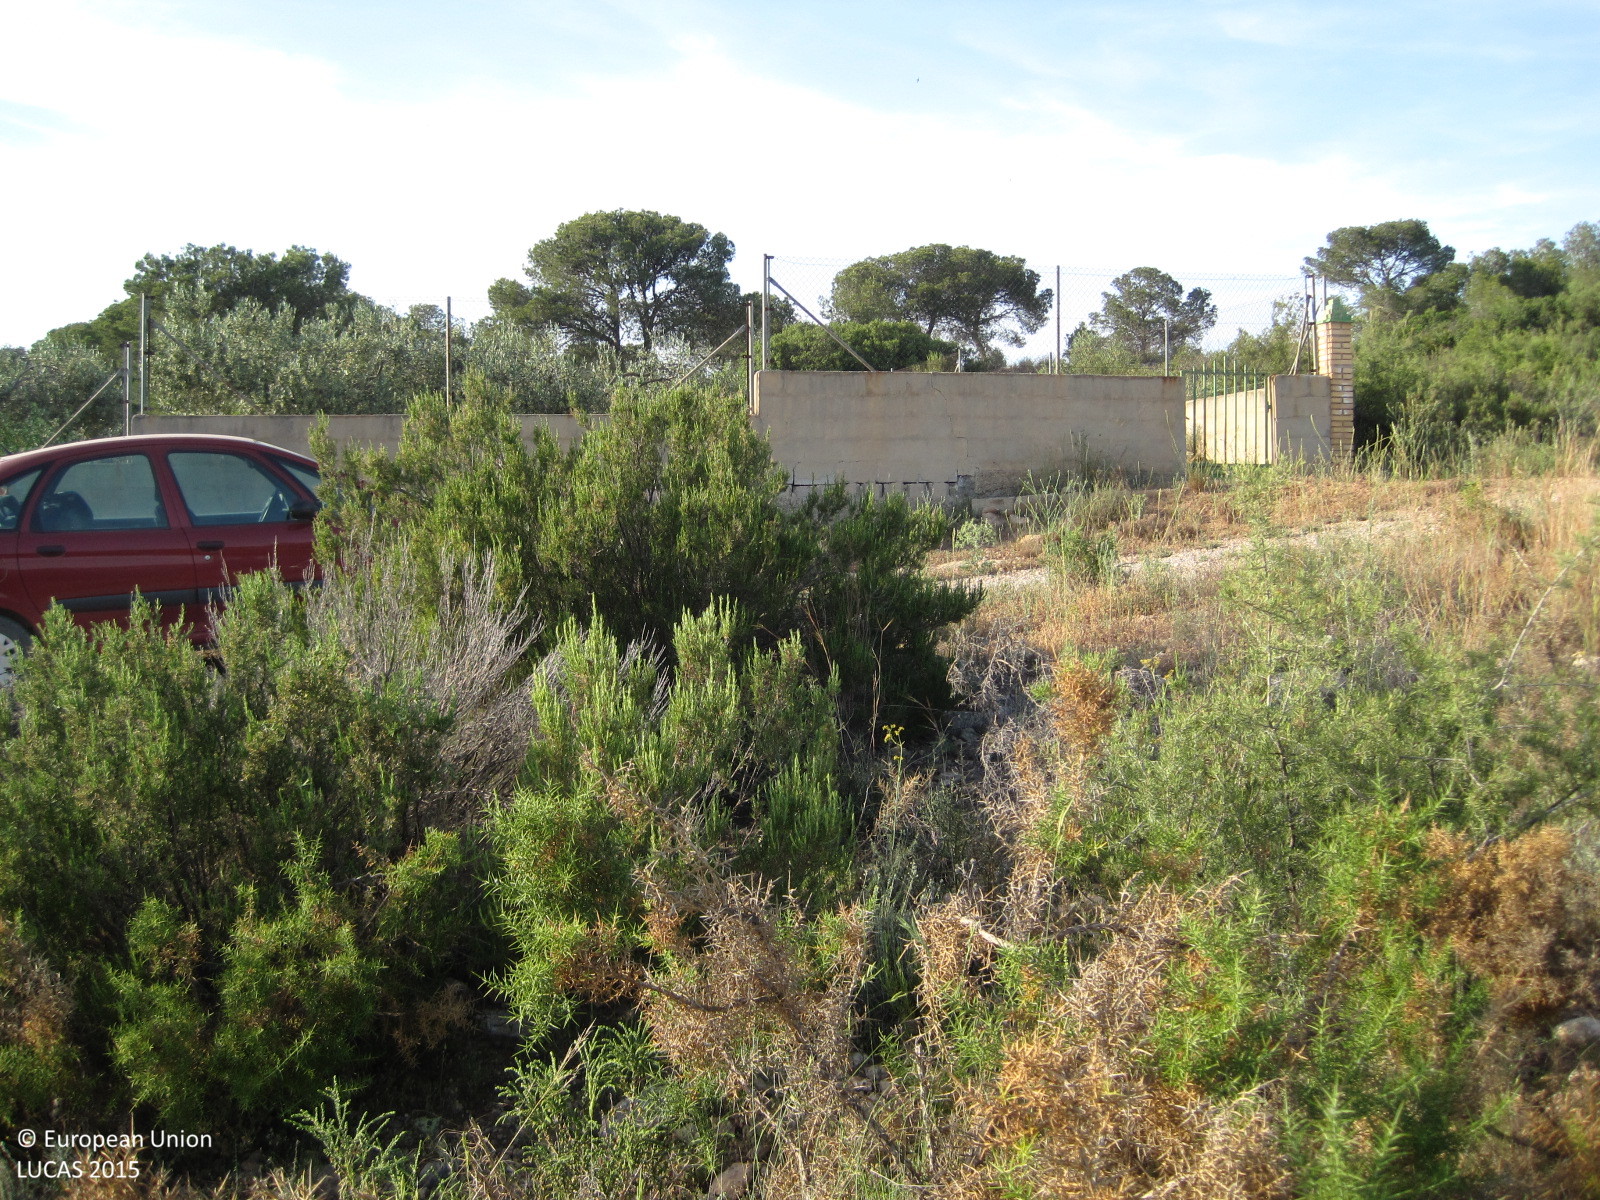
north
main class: Shrubland
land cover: Shrubland without tree cover
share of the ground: > 75 %
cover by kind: shrubs 80 %, consolidated bare surface 15 %, herbaceous plants 5 %
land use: Semi-natural and natural areas not in use
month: May
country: ES
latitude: 39.6838
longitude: -0.6696
